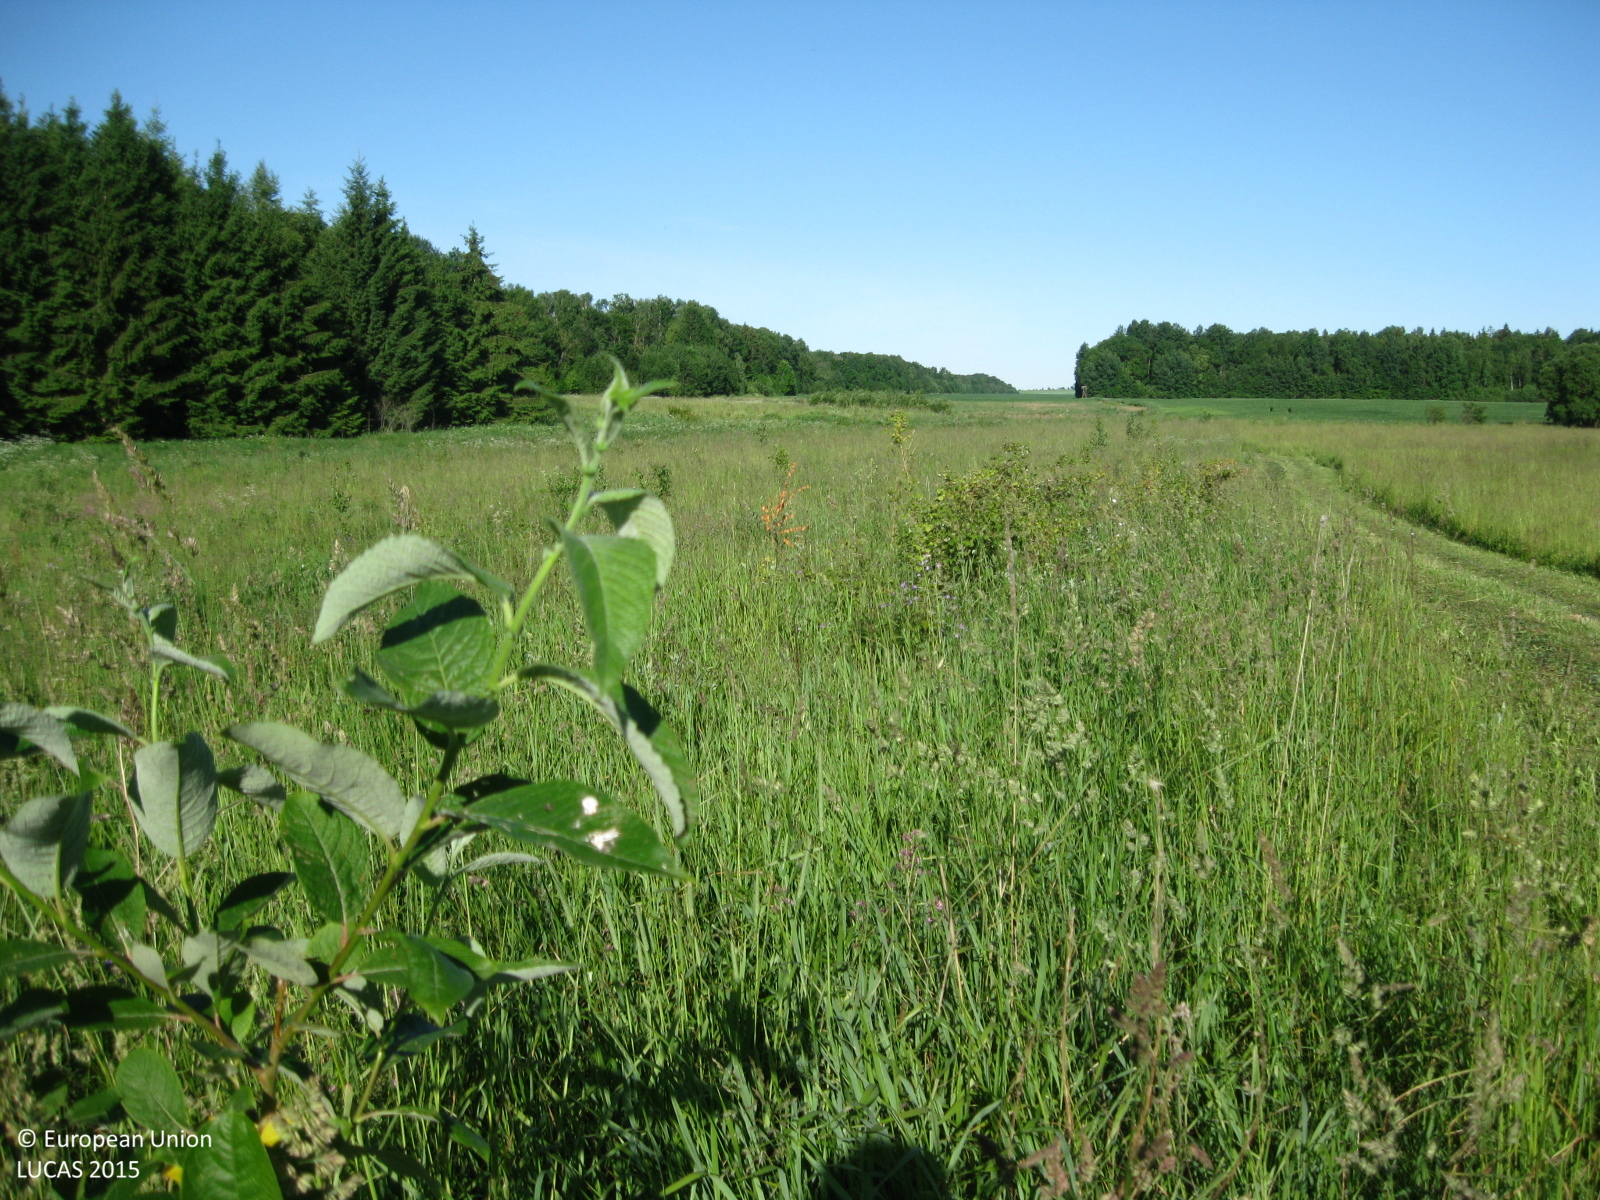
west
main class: Grassland
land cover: Grassland without tree/shrub cover
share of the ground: > 75 %
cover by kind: herbaceous plants 100 %
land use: Agriculture (excluding fallow land and kitchen gardens)
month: June
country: LT
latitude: 55.3505
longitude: 23.7581
